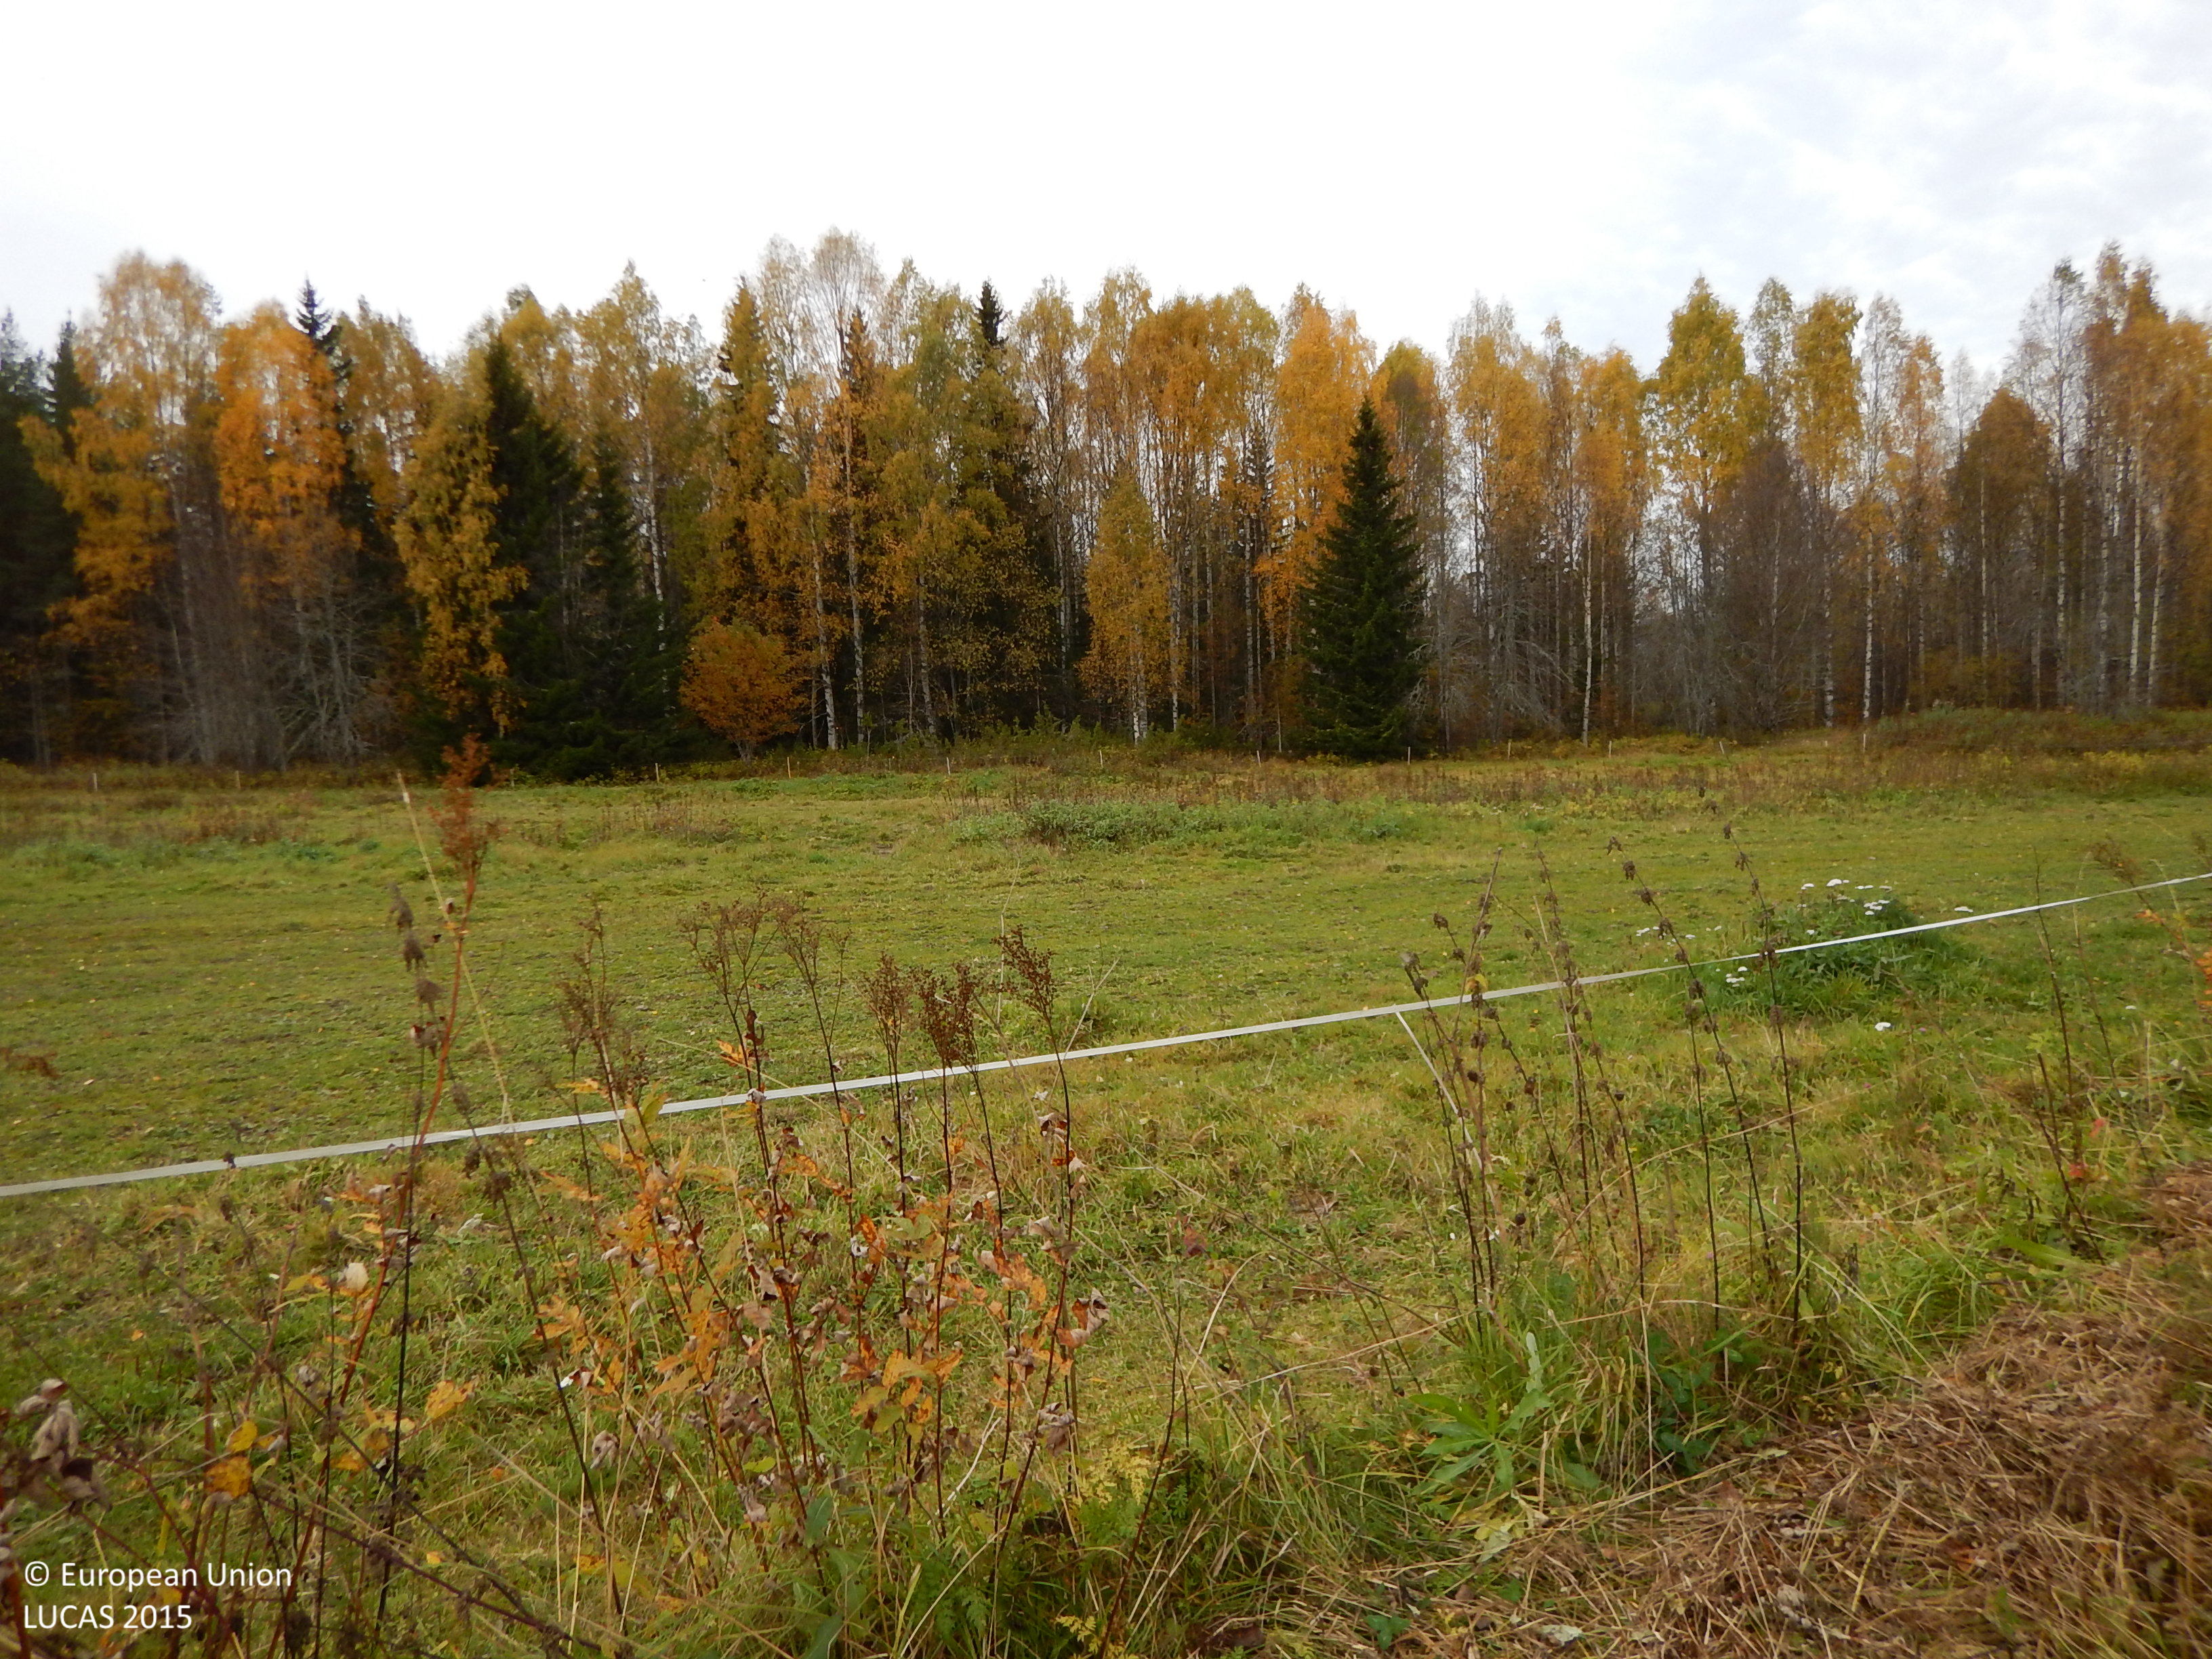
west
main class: Grassland
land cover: Grassland without tree/shrub cover
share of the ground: > 75 %
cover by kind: herbaceous plants 100 %
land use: Agriculture (excluding fallow land and kitchen gardens)
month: October
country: SE
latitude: 64.8455
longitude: 20.8773
